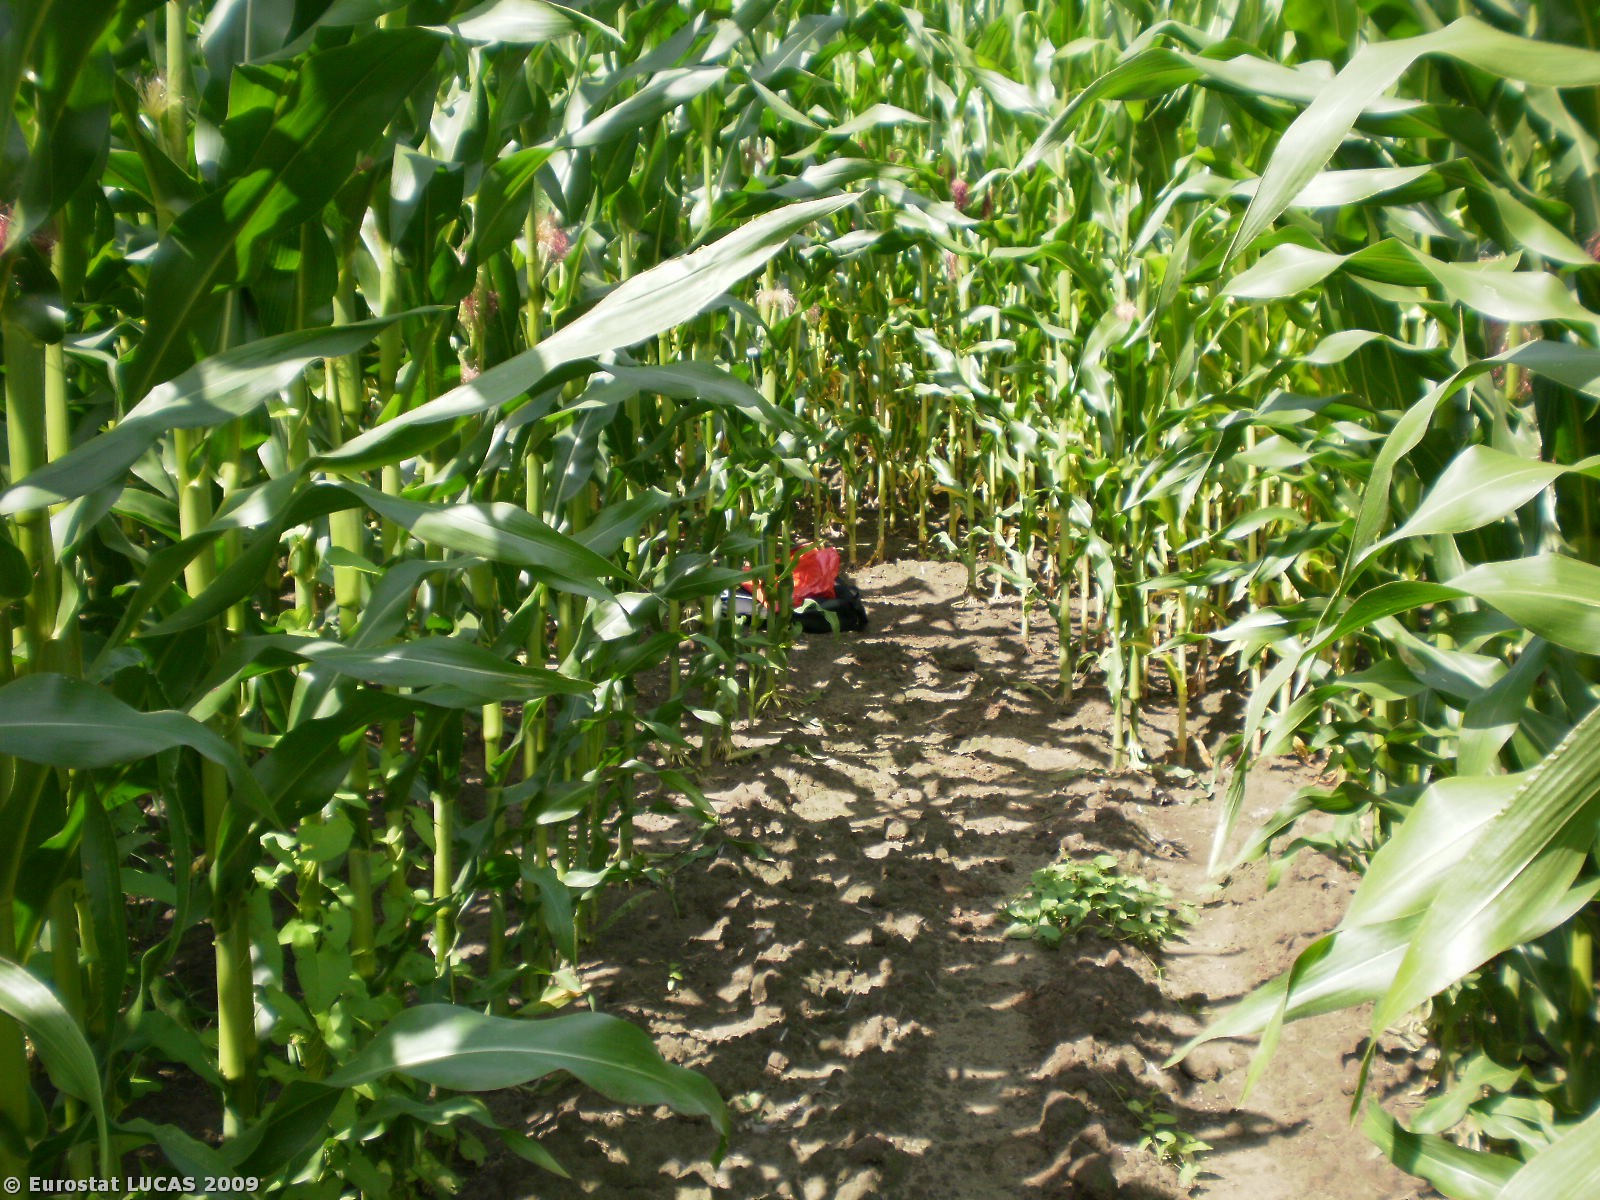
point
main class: Cropland
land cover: Maize
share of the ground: > 75 %
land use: Agriculture (excluding fallow land and kitchen gardens)
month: July
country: BE
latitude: 51.0112
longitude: 4.2224
